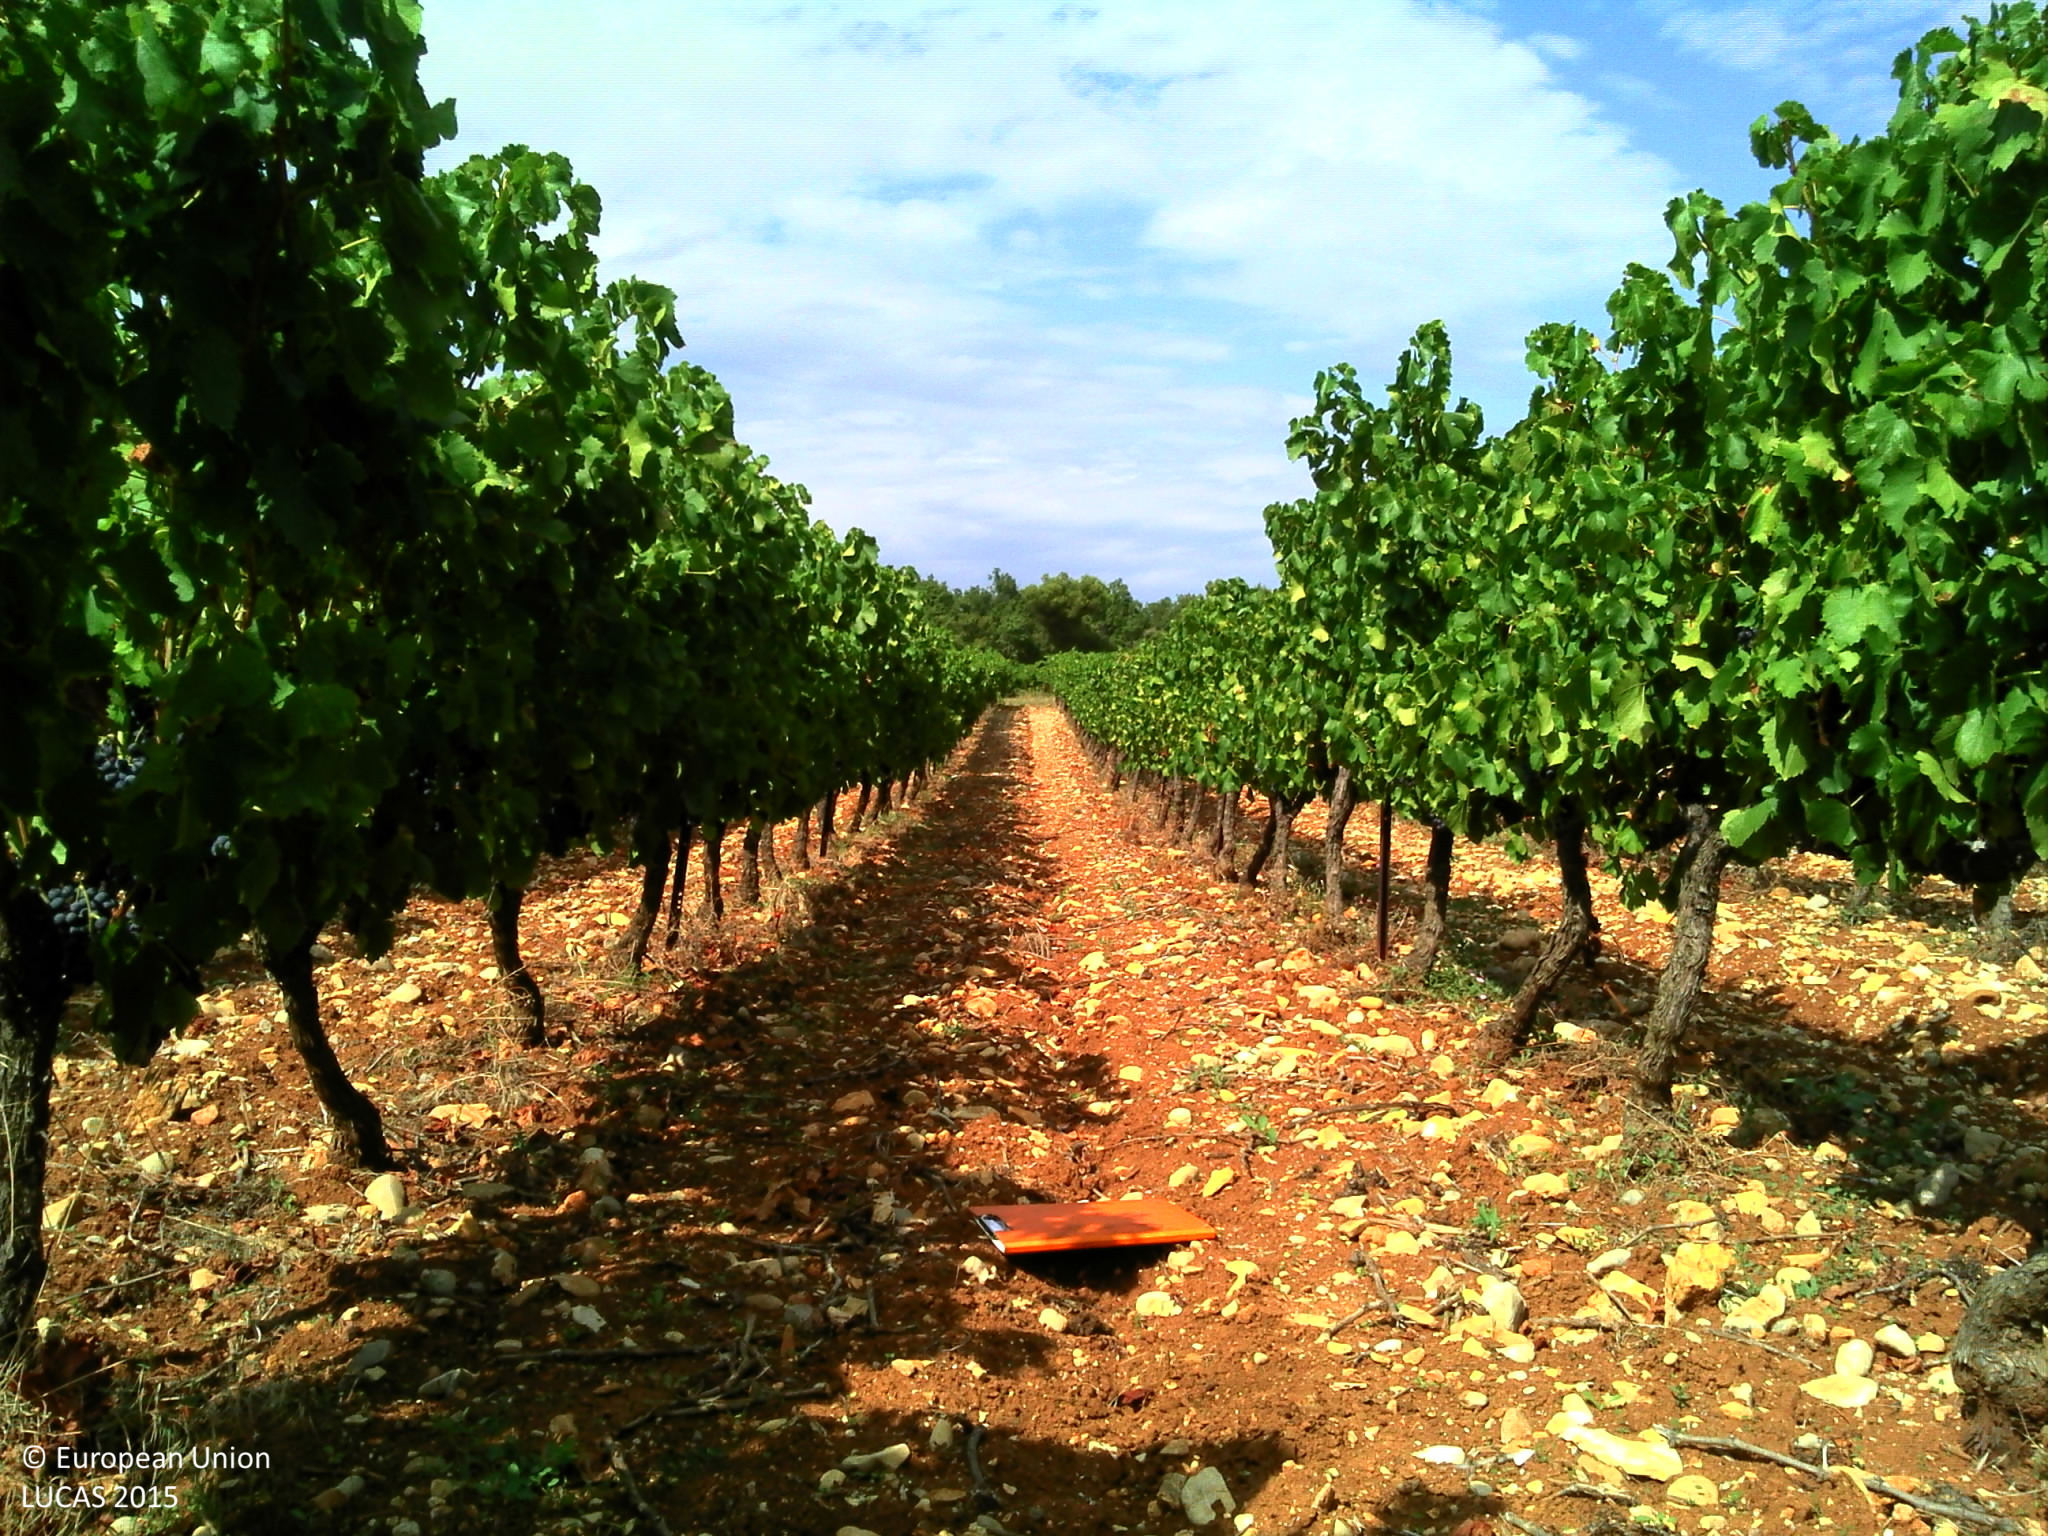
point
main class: Cropland
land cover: Vineyards
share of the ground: 10 - 25 %
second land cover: Other bare soil
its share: > 75 %
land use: Agriculture (excluding fallow land and kitchen gardens)
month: September
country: FR
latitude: 44.3206
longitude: 5.0046
